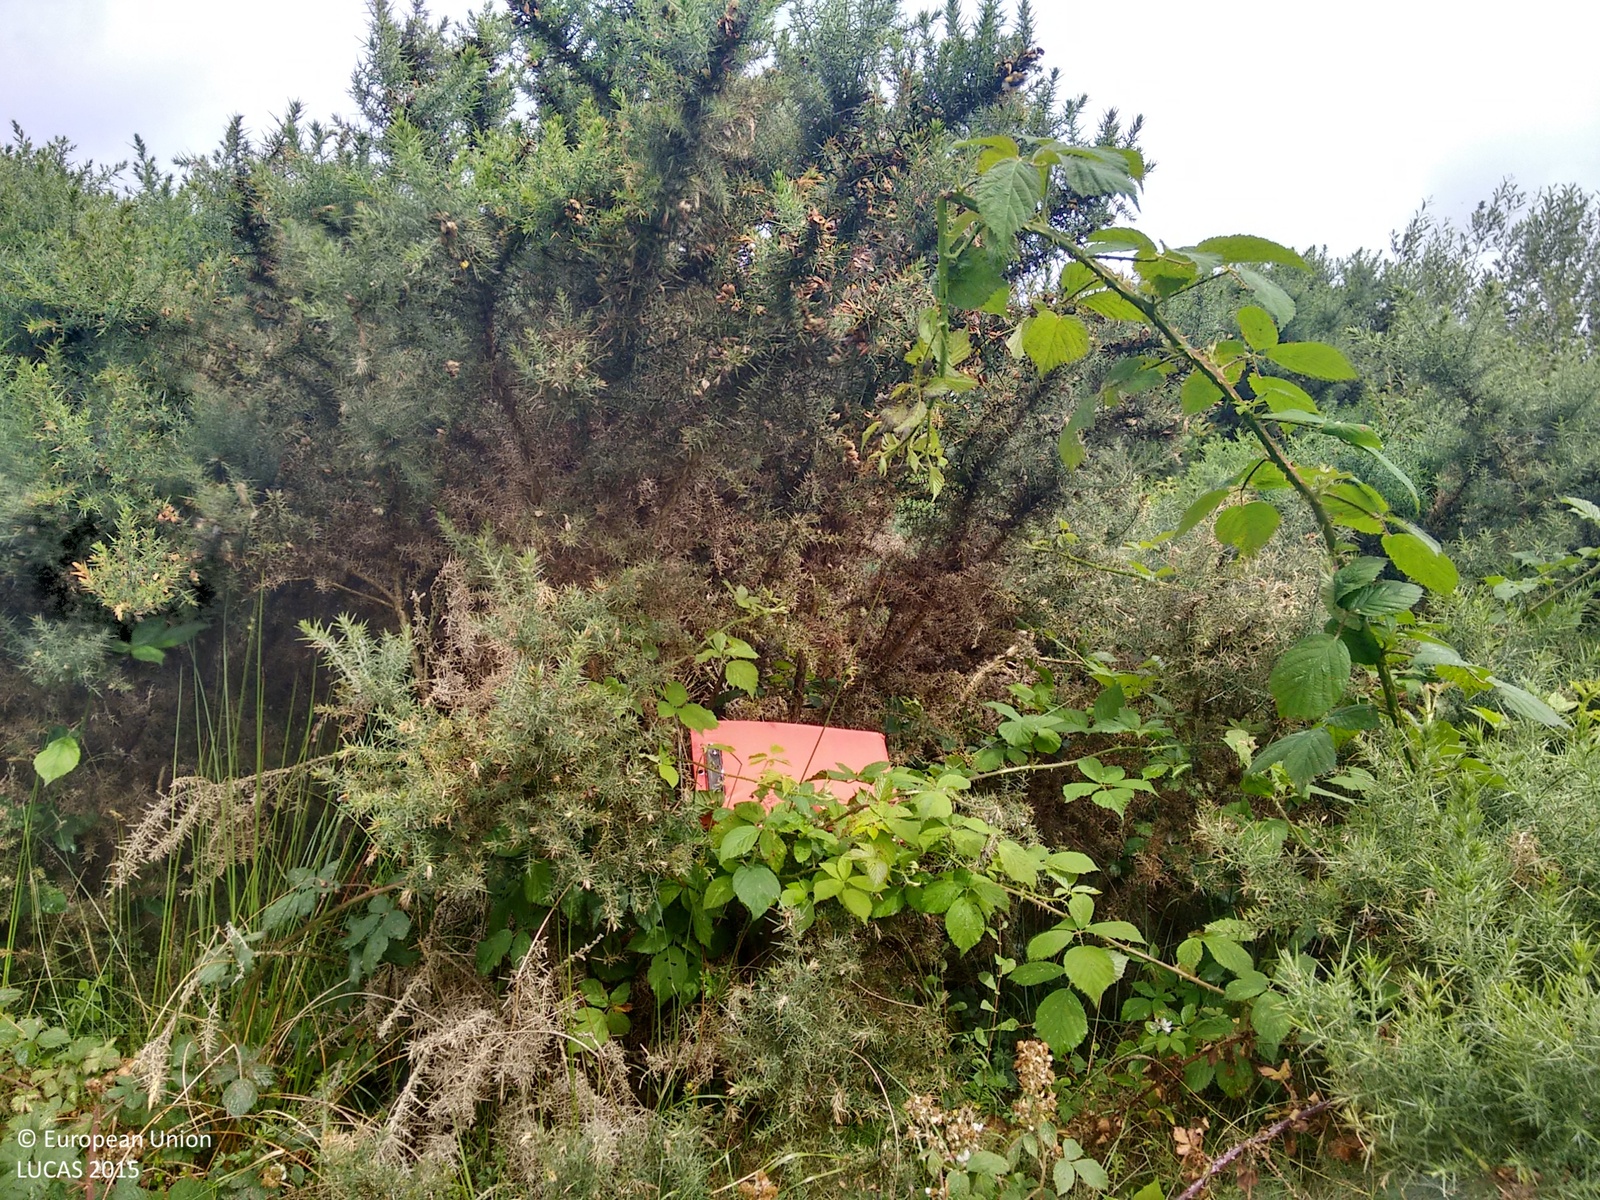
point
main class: Shrubland
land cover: Shrubland with sparse tree cover
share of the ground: > 75 %
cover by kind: shrubs 90 %, broadleaved forest trees 5 %, herbaceous plants 5 %
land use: Abandoned areas
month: July
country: IE
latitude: 51.6702
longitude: -9.2365
